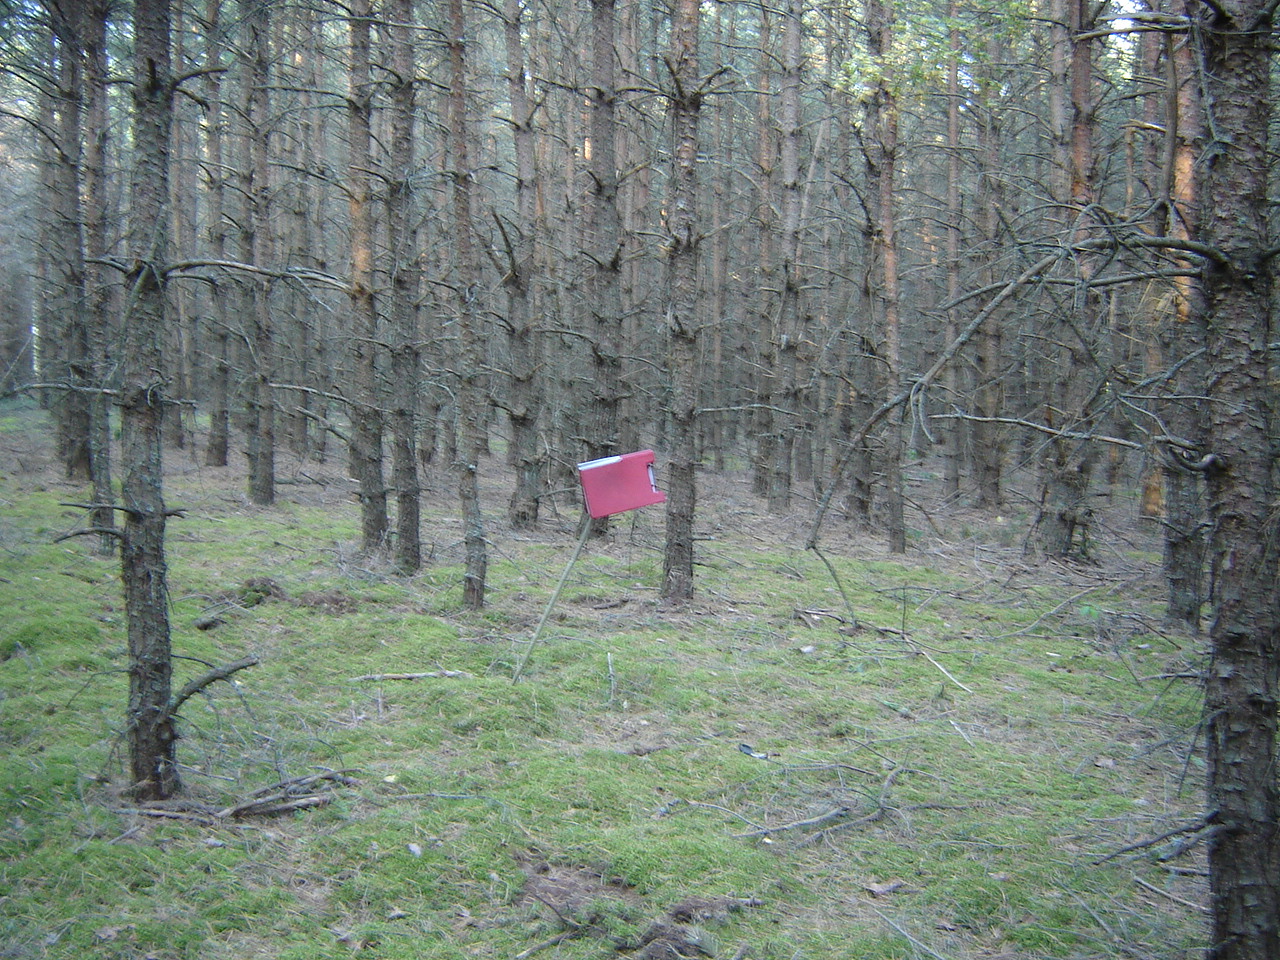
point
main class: Woodland
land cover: Pine dominated coniferous woodland
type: hemiboreal forest and nemoral coniferous forest and mixed broadleaved-coniferous forest
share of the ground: > 75 %
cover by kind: coniferous forest trees 90 %, lichens and mosses 10 %
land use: Forestry
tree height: > 5 m
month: August
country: LT
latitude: 54.5658
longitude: 24.8504
